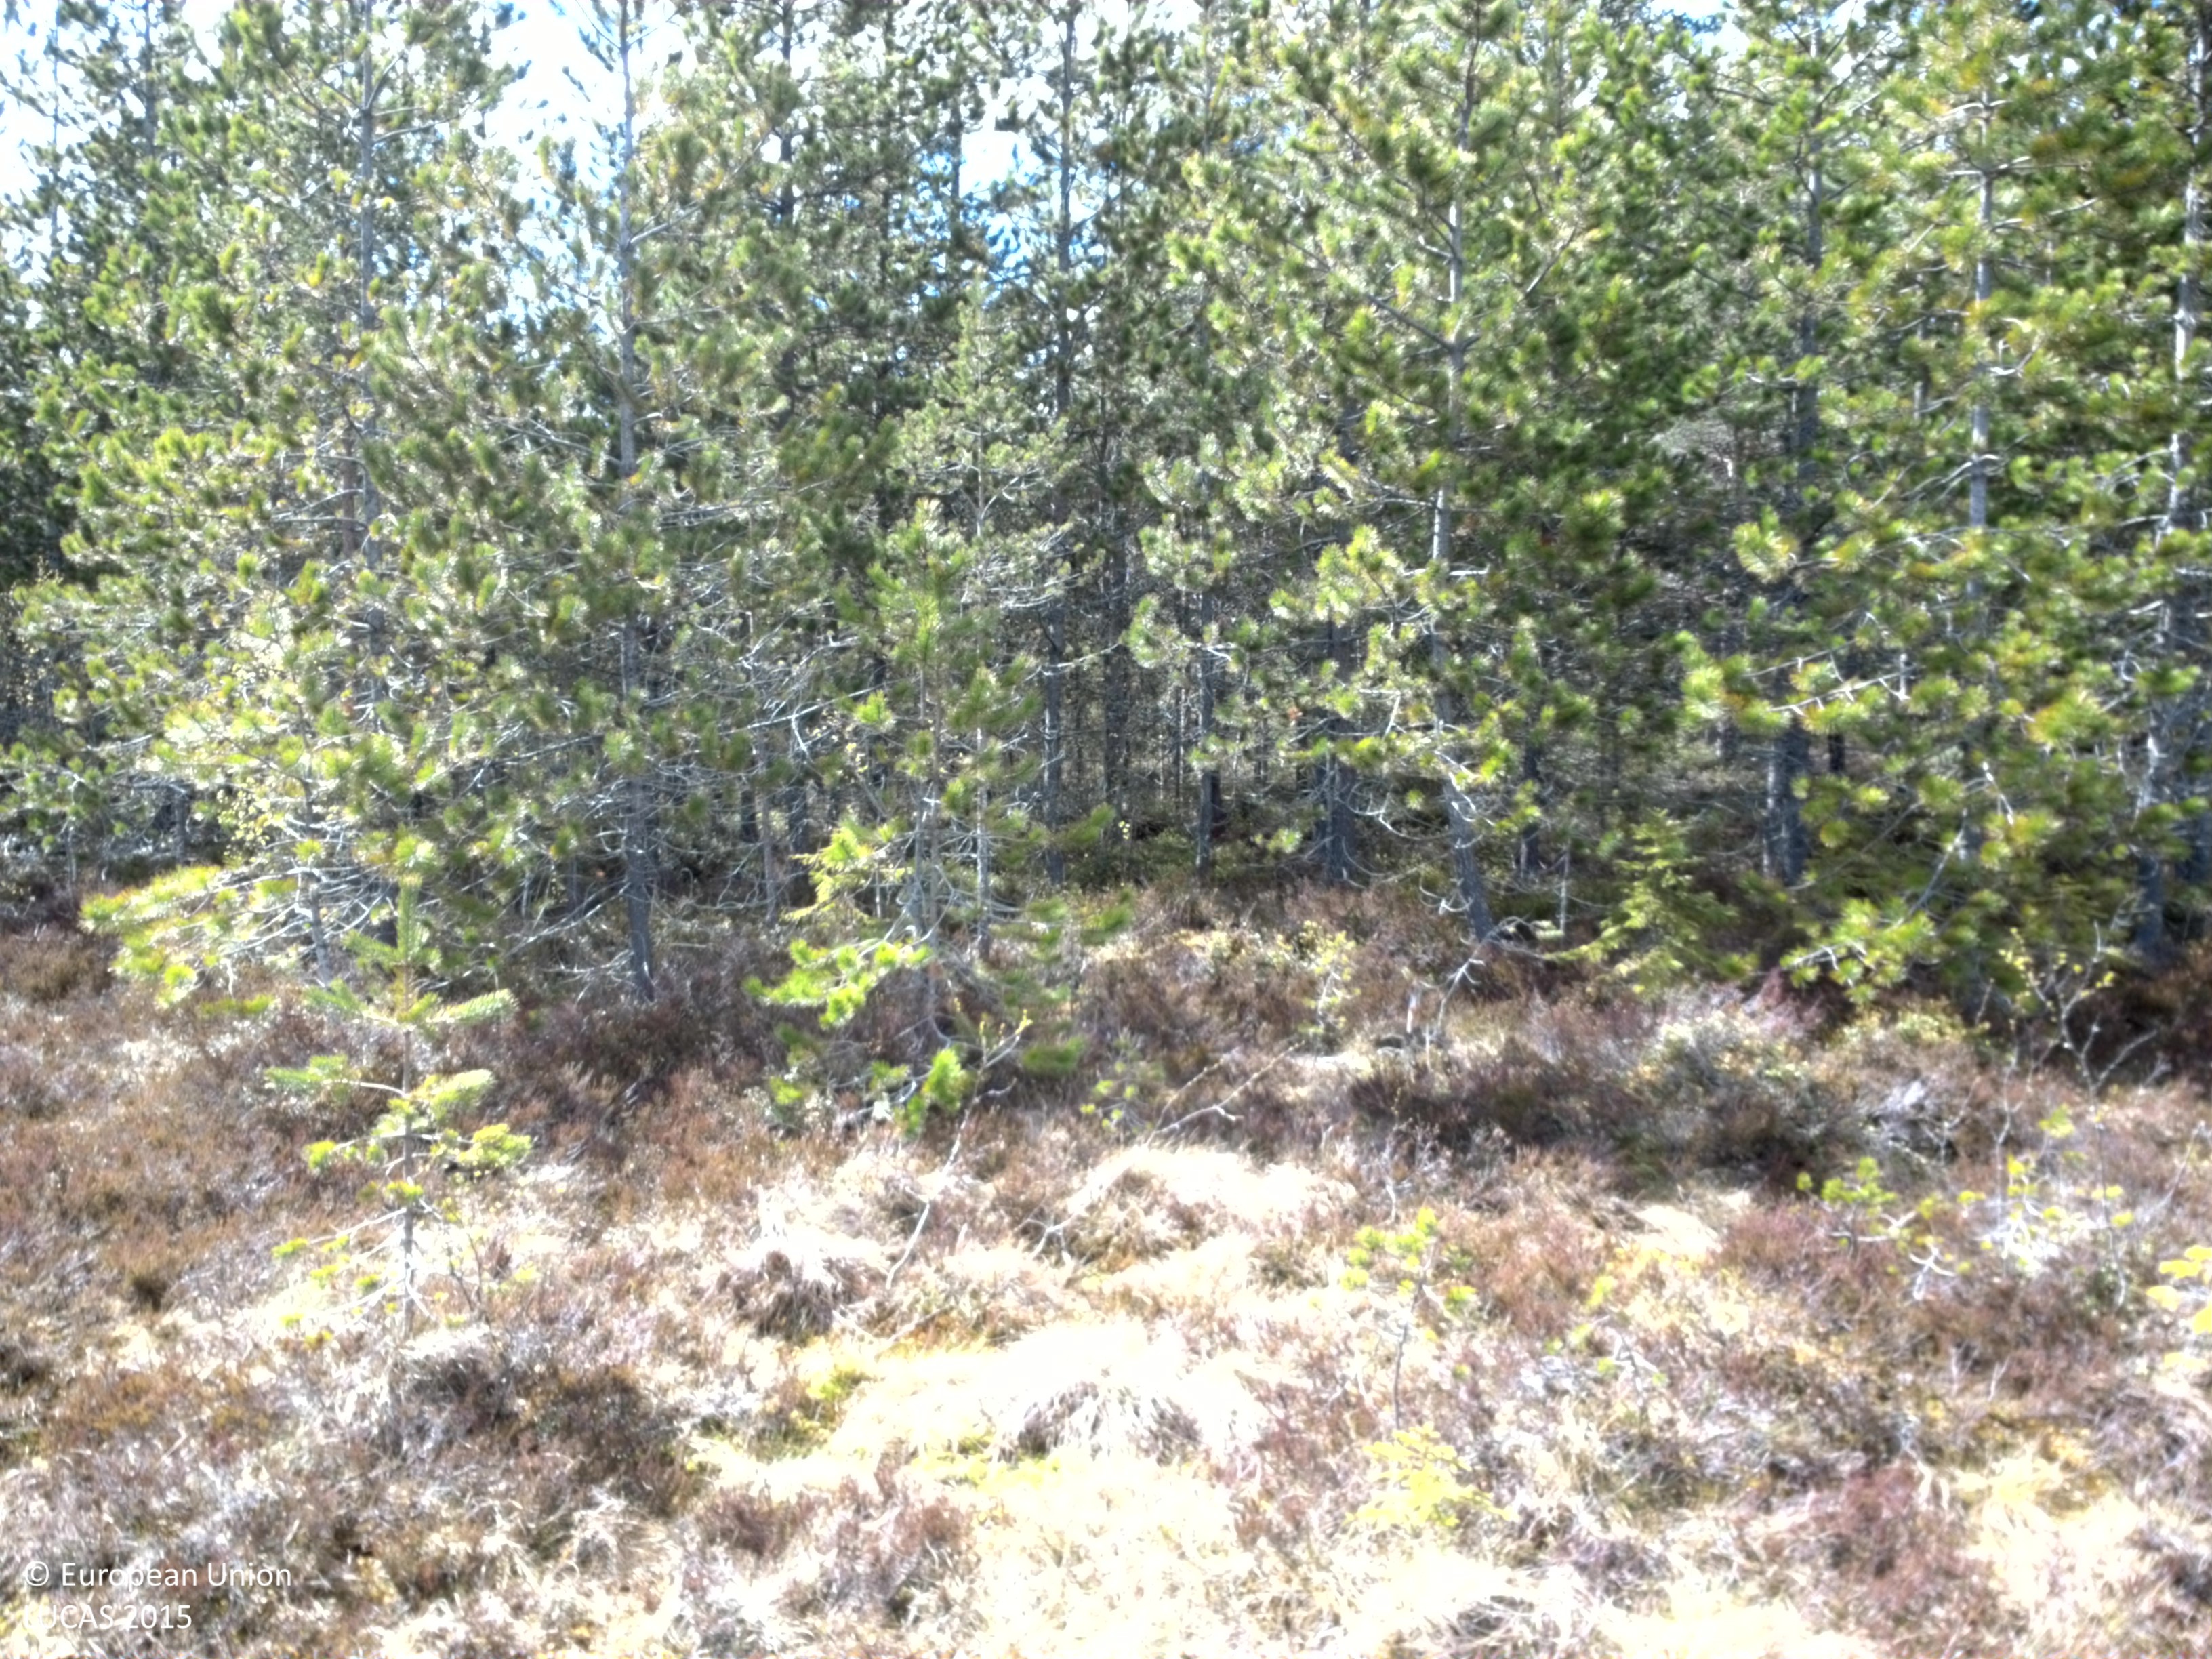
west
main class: Woodland
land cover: Pine dominated coniferous woodland
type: mire and swamp forests
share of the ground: 10 - 25 %
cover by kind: herbaceous plants 45 %, shrubs 40 %, coniferous forest trees 15 %
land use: Semi-natural and natural areas not in use
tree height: > 5 m
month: May
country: SE
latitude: 60.4059
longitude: 13.5659
